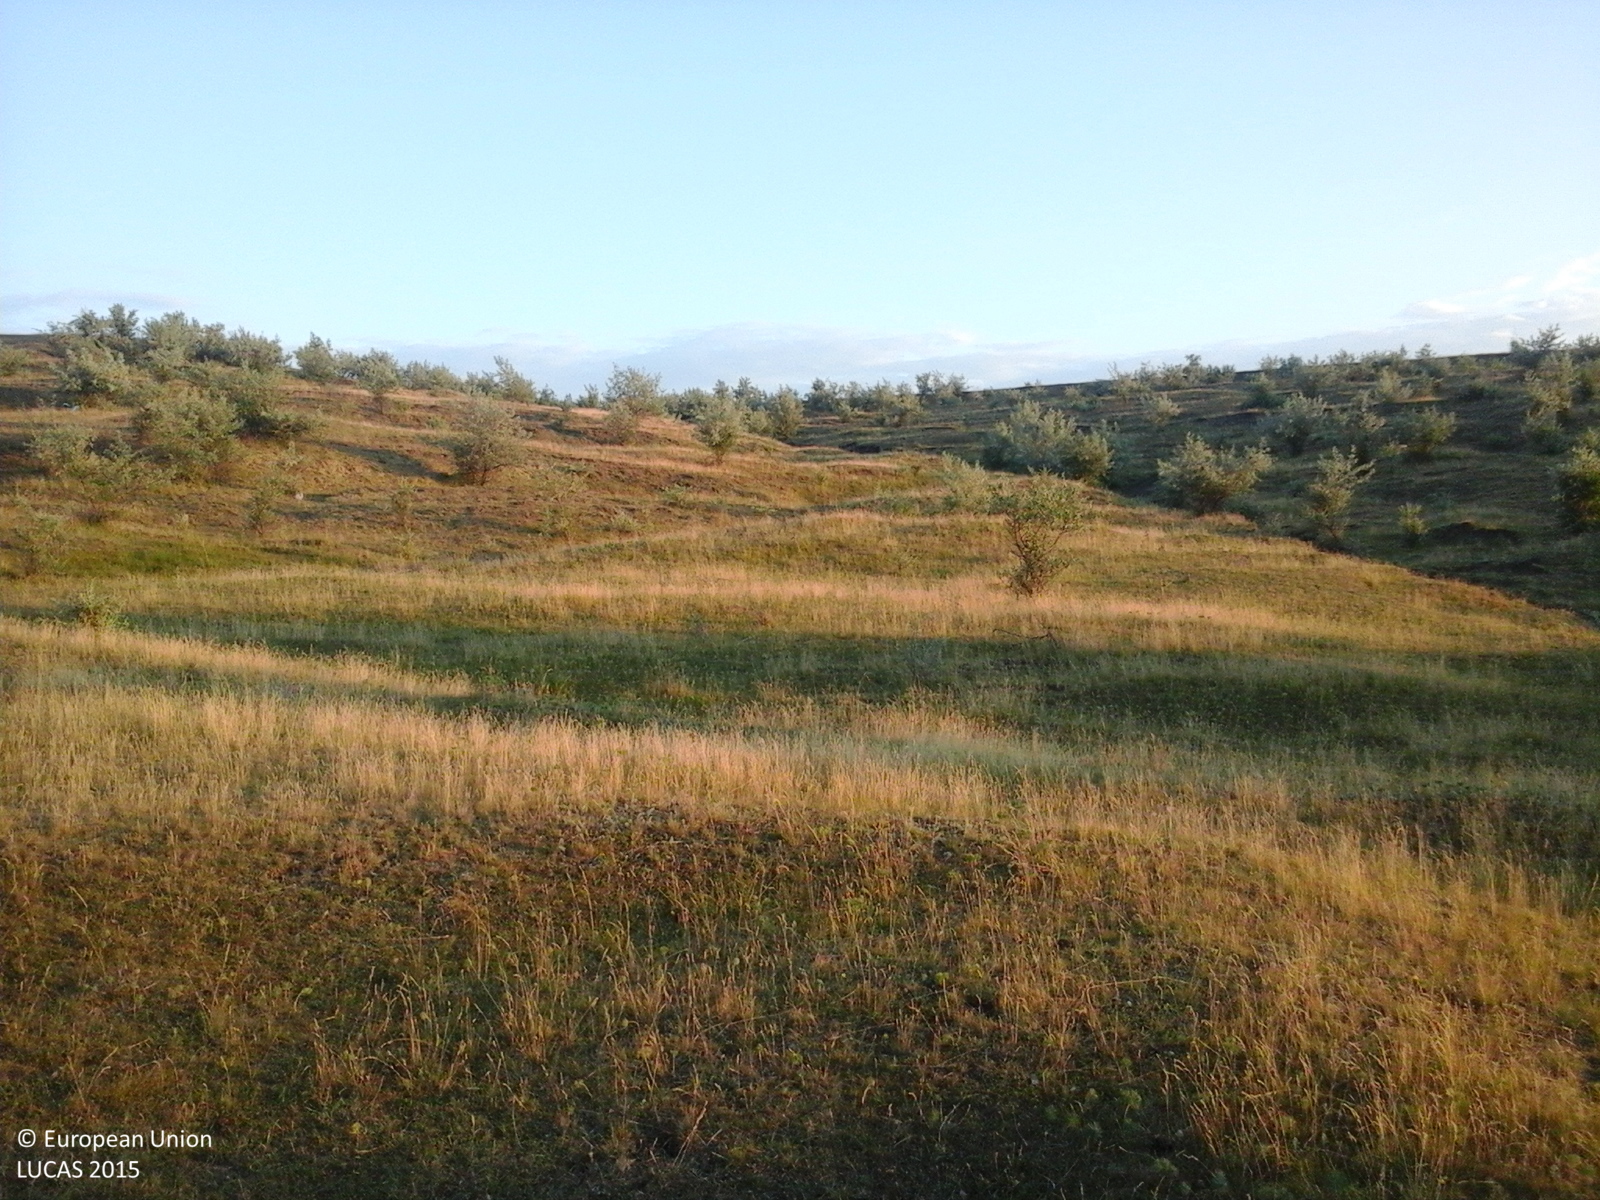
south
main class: Grassland
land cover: Grassland without tree/shrub cover
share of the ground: > 75 %
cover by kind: herbaceous plants 100 %
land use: Agriculture (excluding fallow land and kitchen gardens)
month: June
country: RO
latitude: 47.7605
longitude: 26.8435
